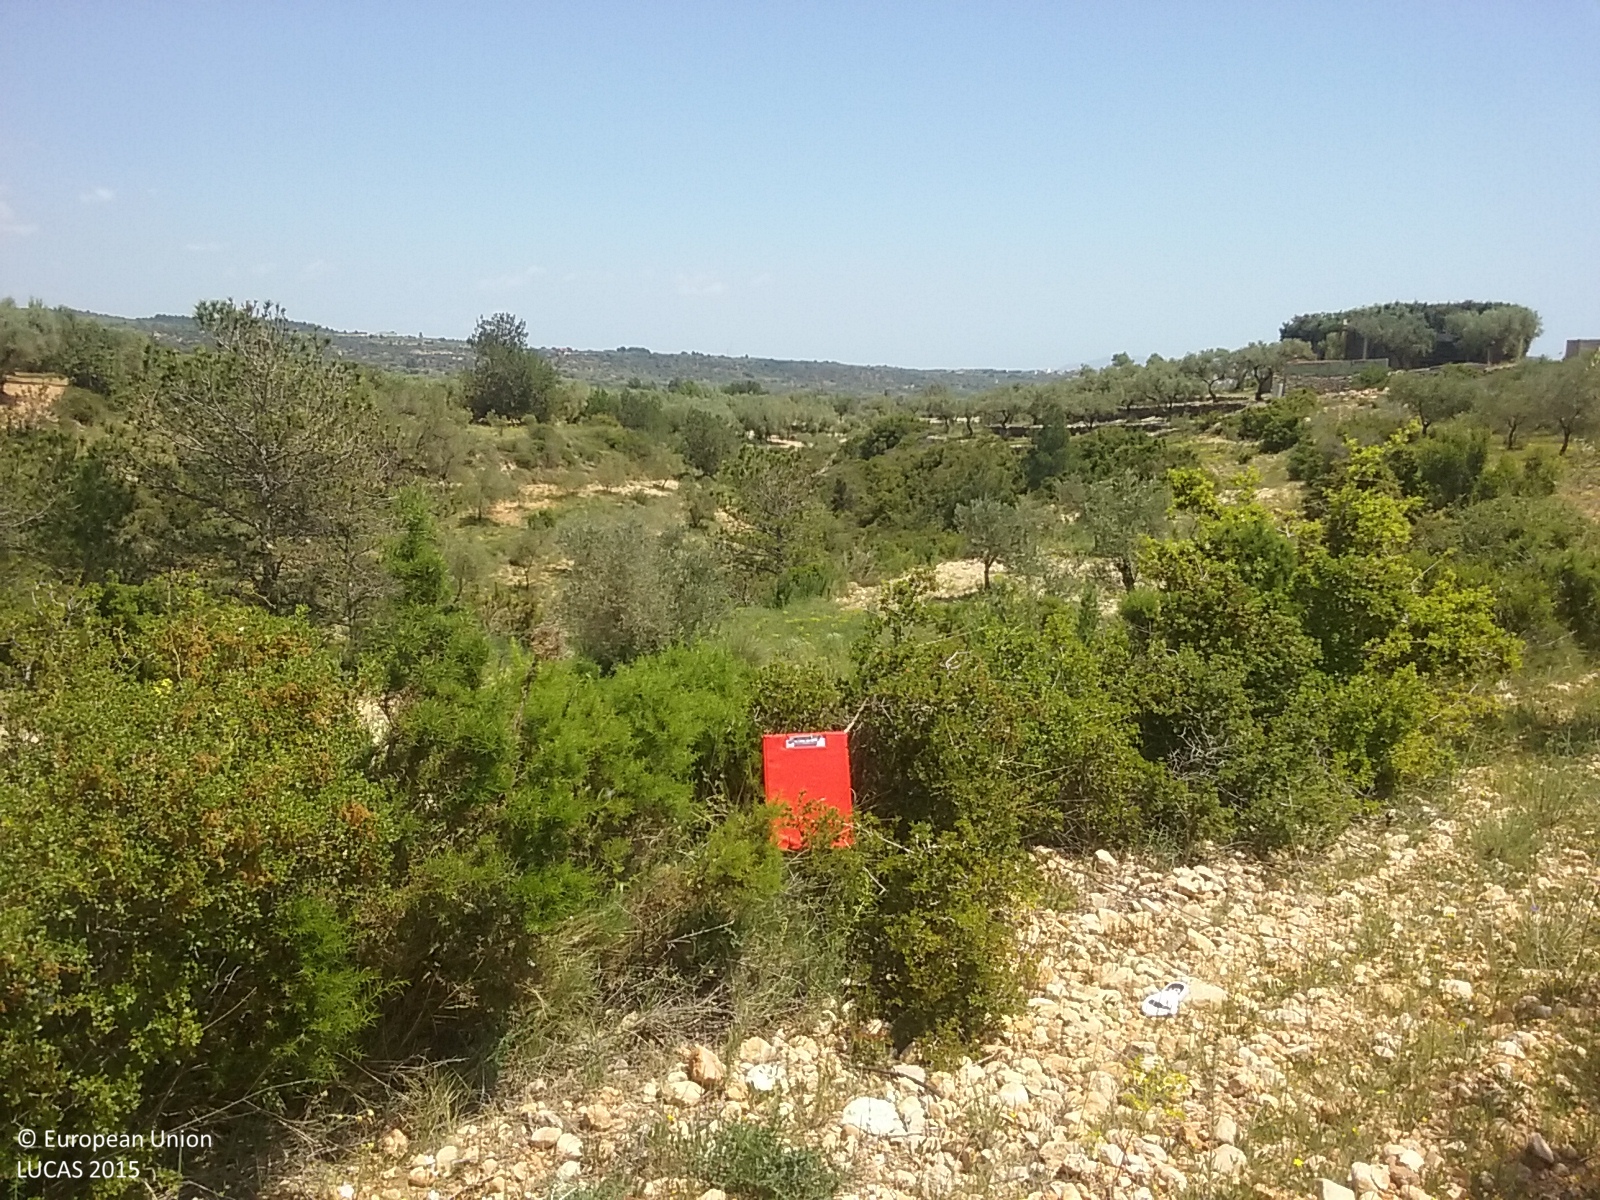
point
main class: Cropland
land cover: Olive groves
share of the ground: 10 - 25 %
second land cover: Other bare soil
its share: > 75 %
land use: Agriculture (excluding fallow land and kitchen gardens)
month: May
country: ES
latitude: 40.5411
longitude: 0.2069
